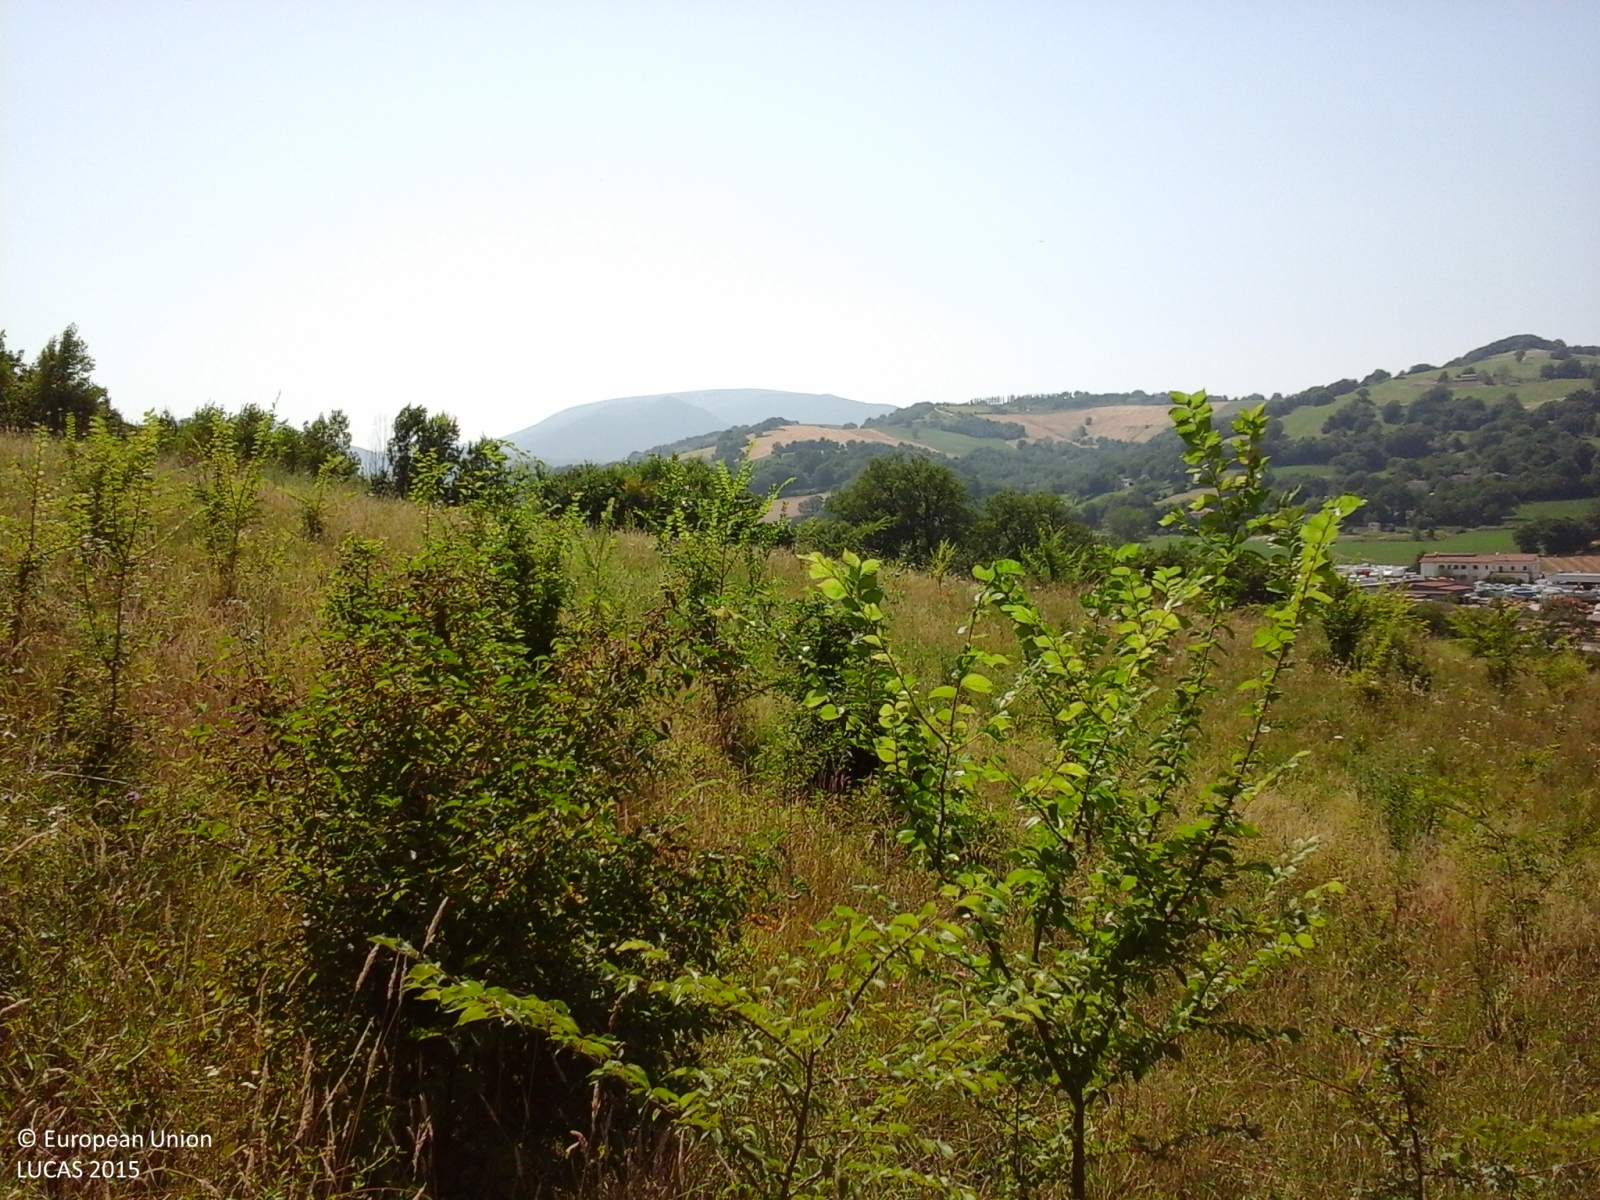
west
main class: Grassland
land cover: Grassland with sparse tree/shrub cover
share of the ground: > 75 %
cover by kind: herbaceous plants 95 %, broadleaved forest trees 5 %
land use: Abandoned areas
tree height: < 5 m
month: July
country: IT
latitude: 43.0875
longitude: 13.3199
